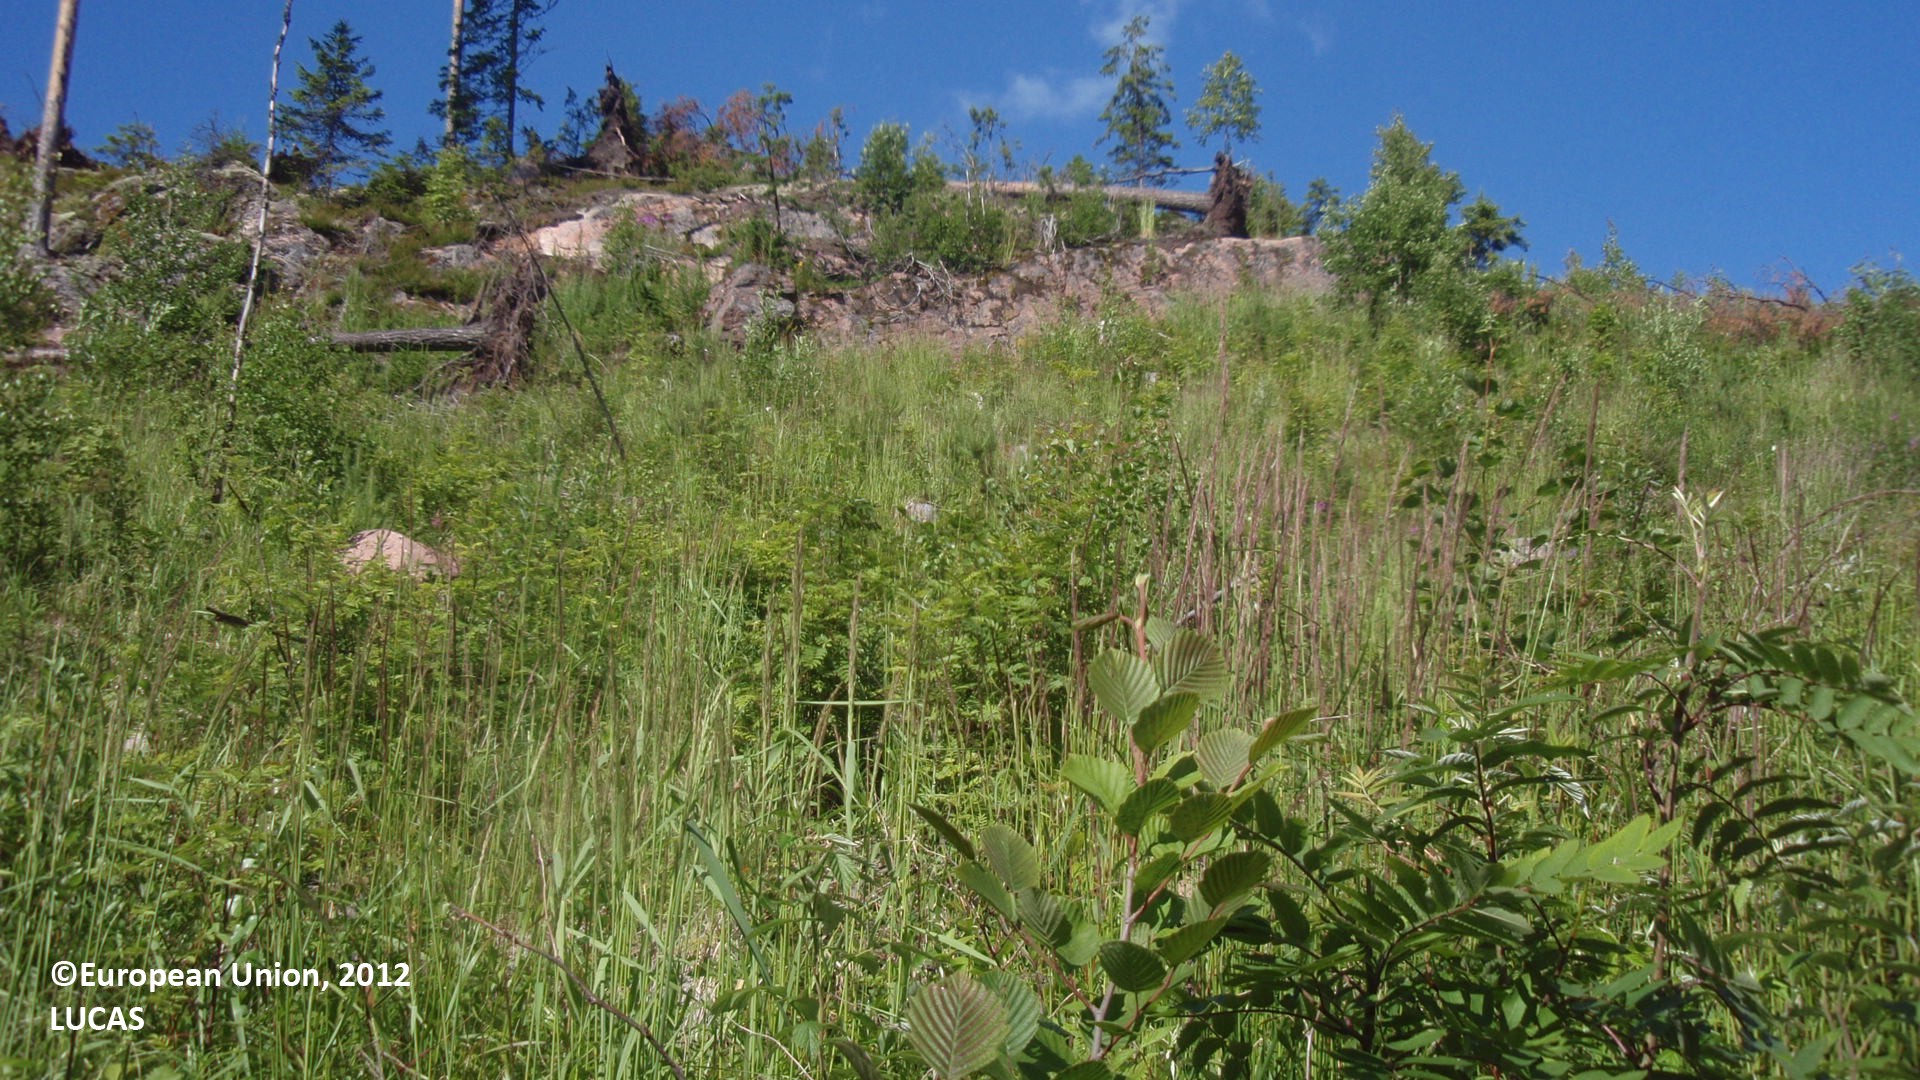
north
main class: Grassland
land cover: Grassland with sparse tree/shrub cover
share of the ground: > 75 %
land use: Forestry
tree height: < 5 m
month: July
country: FI
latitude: 61.5884
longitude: 28.8573
